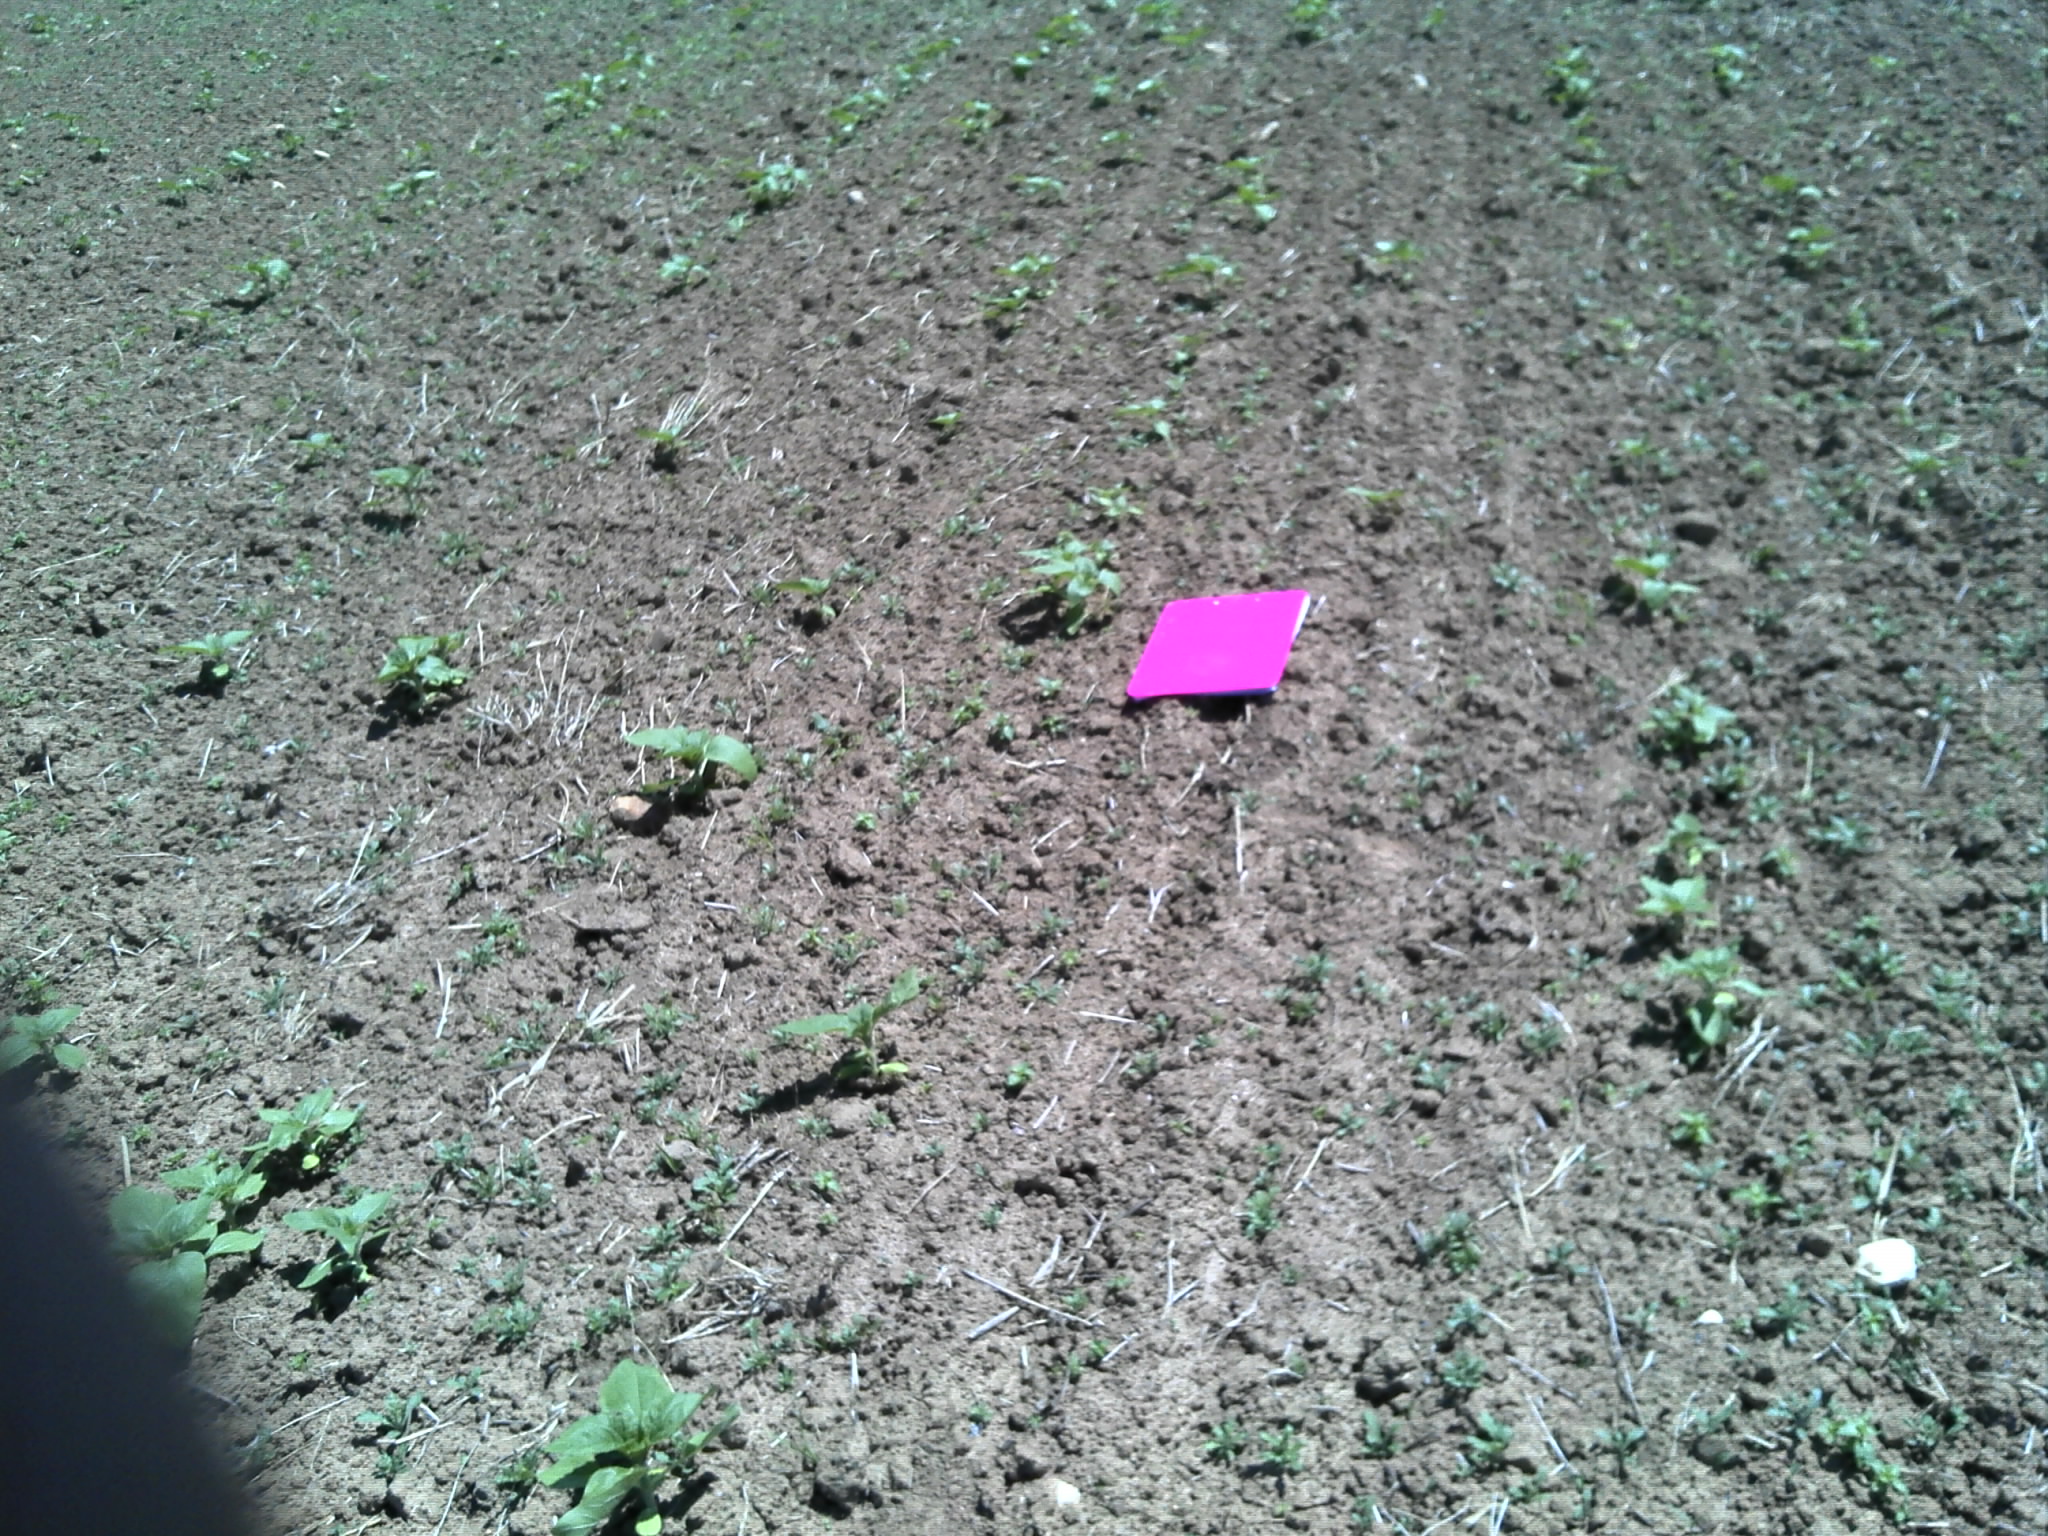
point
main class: Cropland
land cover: Sunflower
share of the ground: 10 - 25 %
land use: Agriculture (excluding fallow land and kitchen gardens)
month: June
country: FR
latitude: 46.5996
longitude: 1.1494
